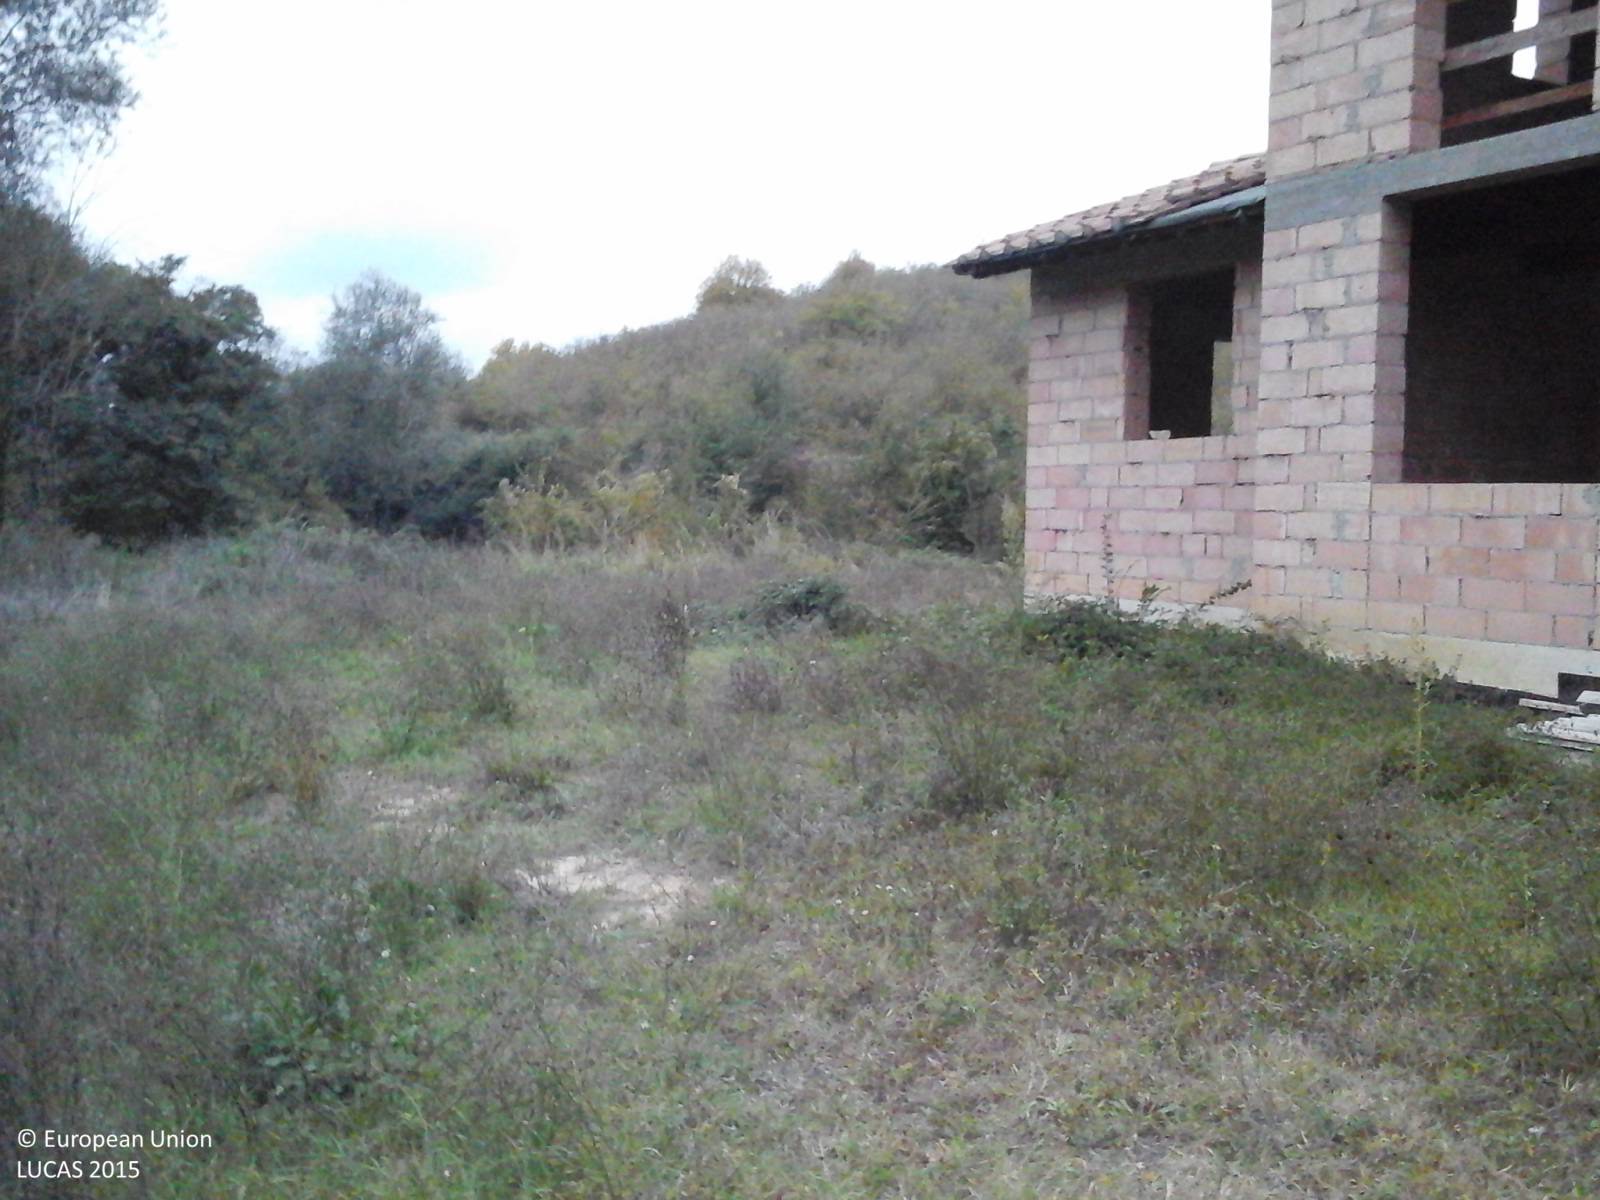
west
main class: Woodland
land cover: Broadleaved woodland
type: thermophilous deciduous forest
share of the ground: > 75 %
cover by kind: broadleaved forest trees 95 %, shrubs 5 %
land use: Forestry
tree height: > 5 m
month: October
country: IT
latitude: 42.6105
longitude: 12.2721
